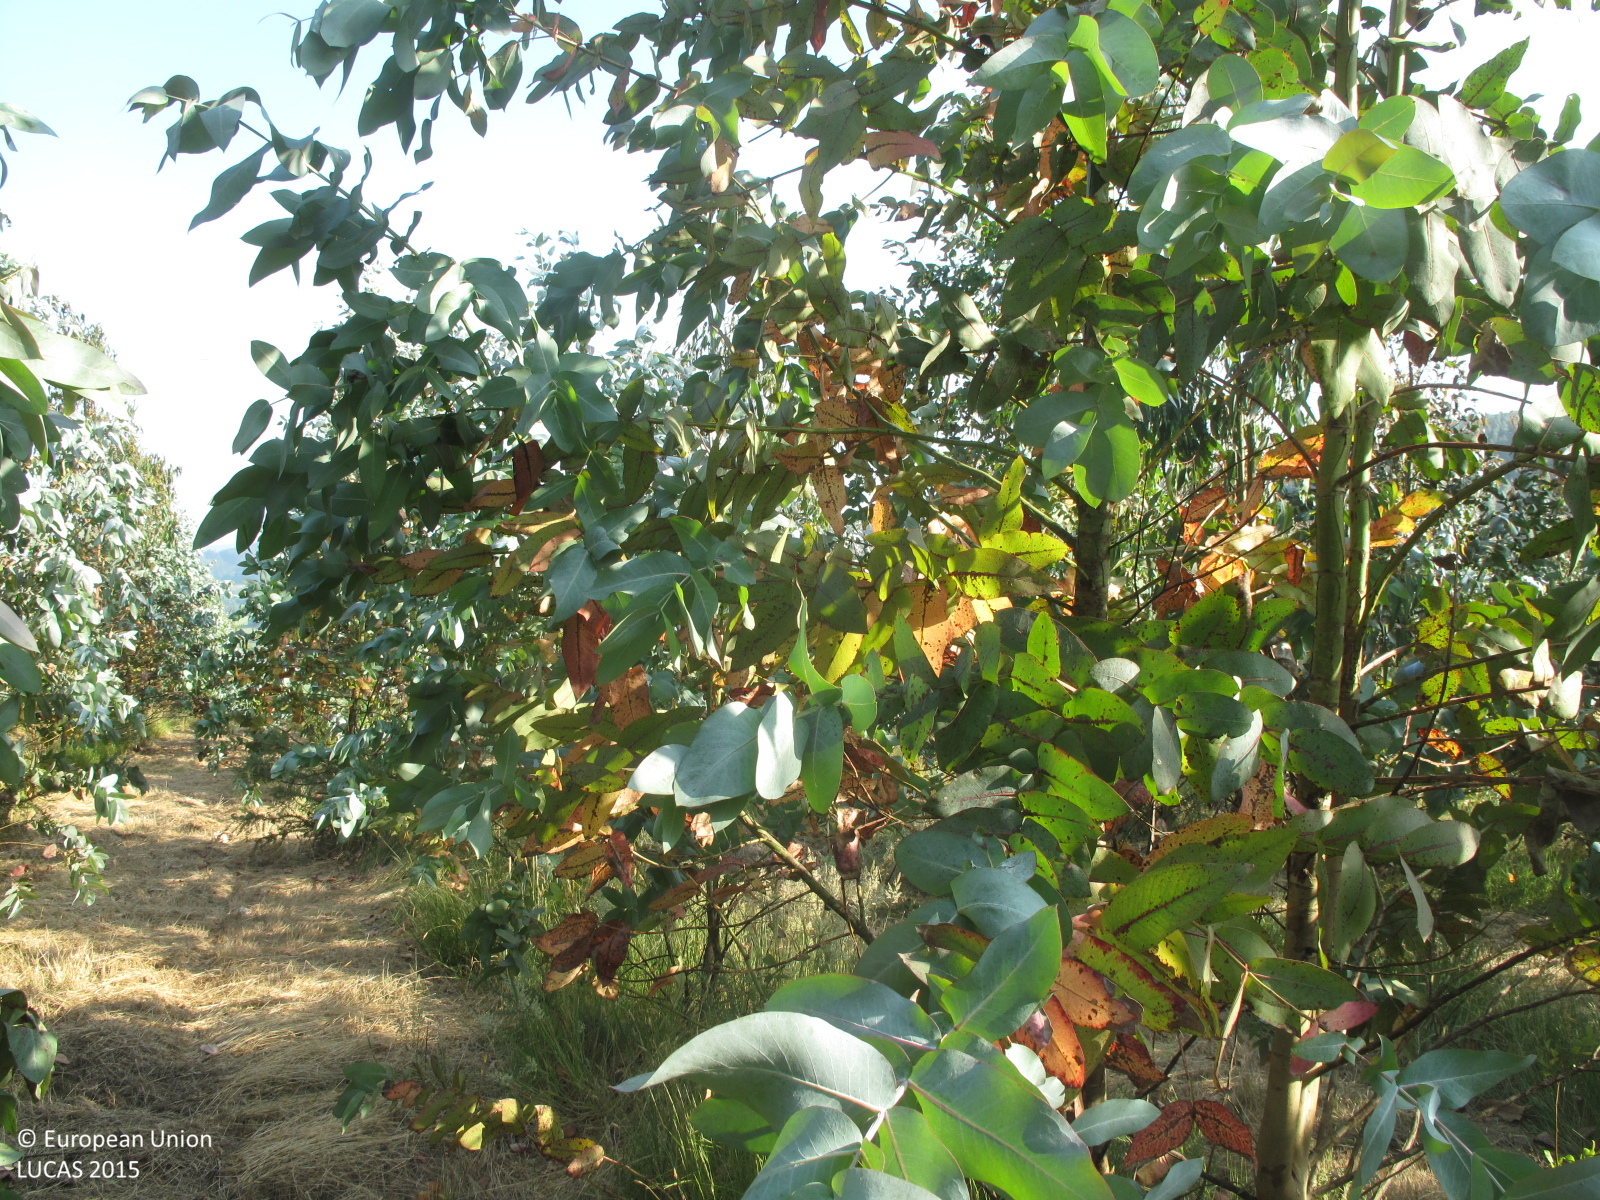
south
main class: Woodland
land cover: Broadleaved woodland
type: exotic forest
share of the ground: 50 - 75 %
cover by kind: broadleaved forest trees 50 %, herbaceous plants 50 %
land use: Forestry
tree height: < 5 m
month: June
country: ES
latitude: 43.0504
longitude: -7.9264
